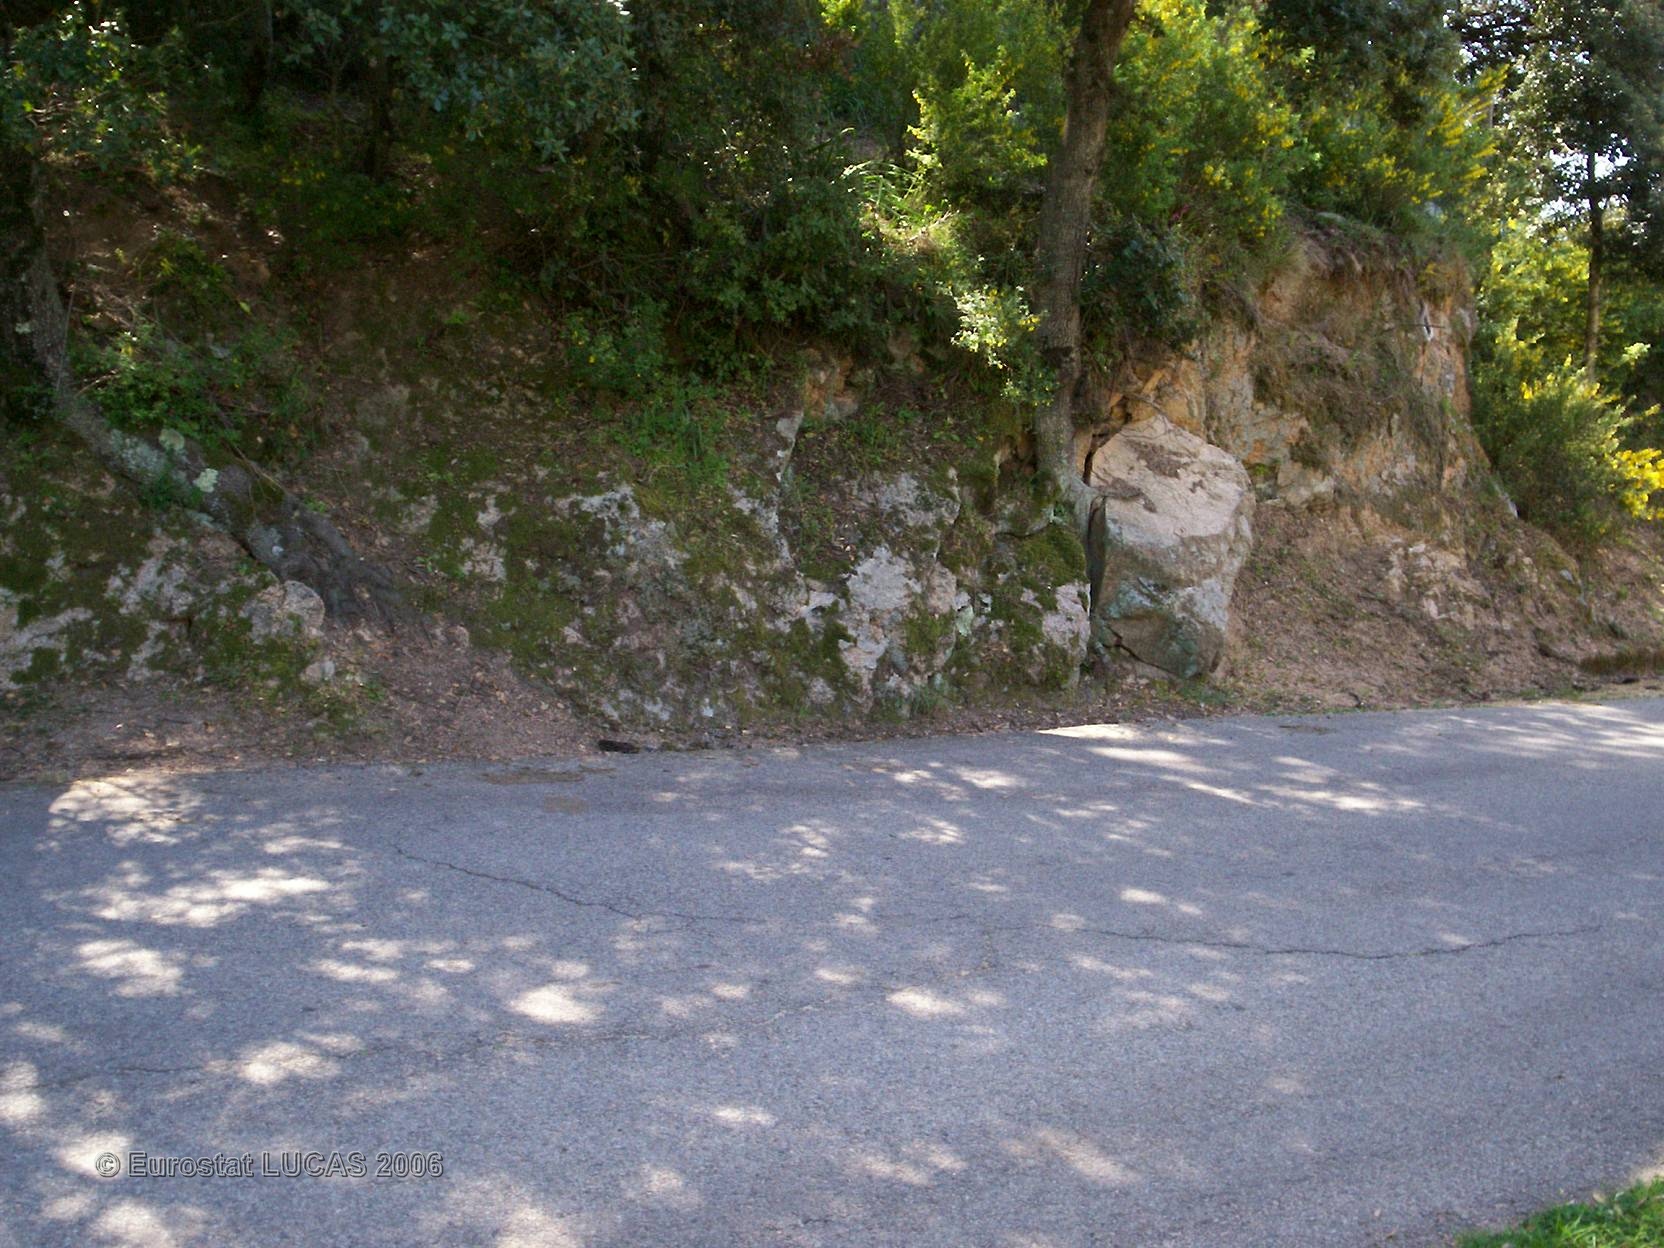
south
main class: Cropland
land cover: Olive groves
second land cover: Shrubland with sparse tree cover
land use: Unused
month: April
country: FR
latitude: 42.1225
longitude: 8.7587
